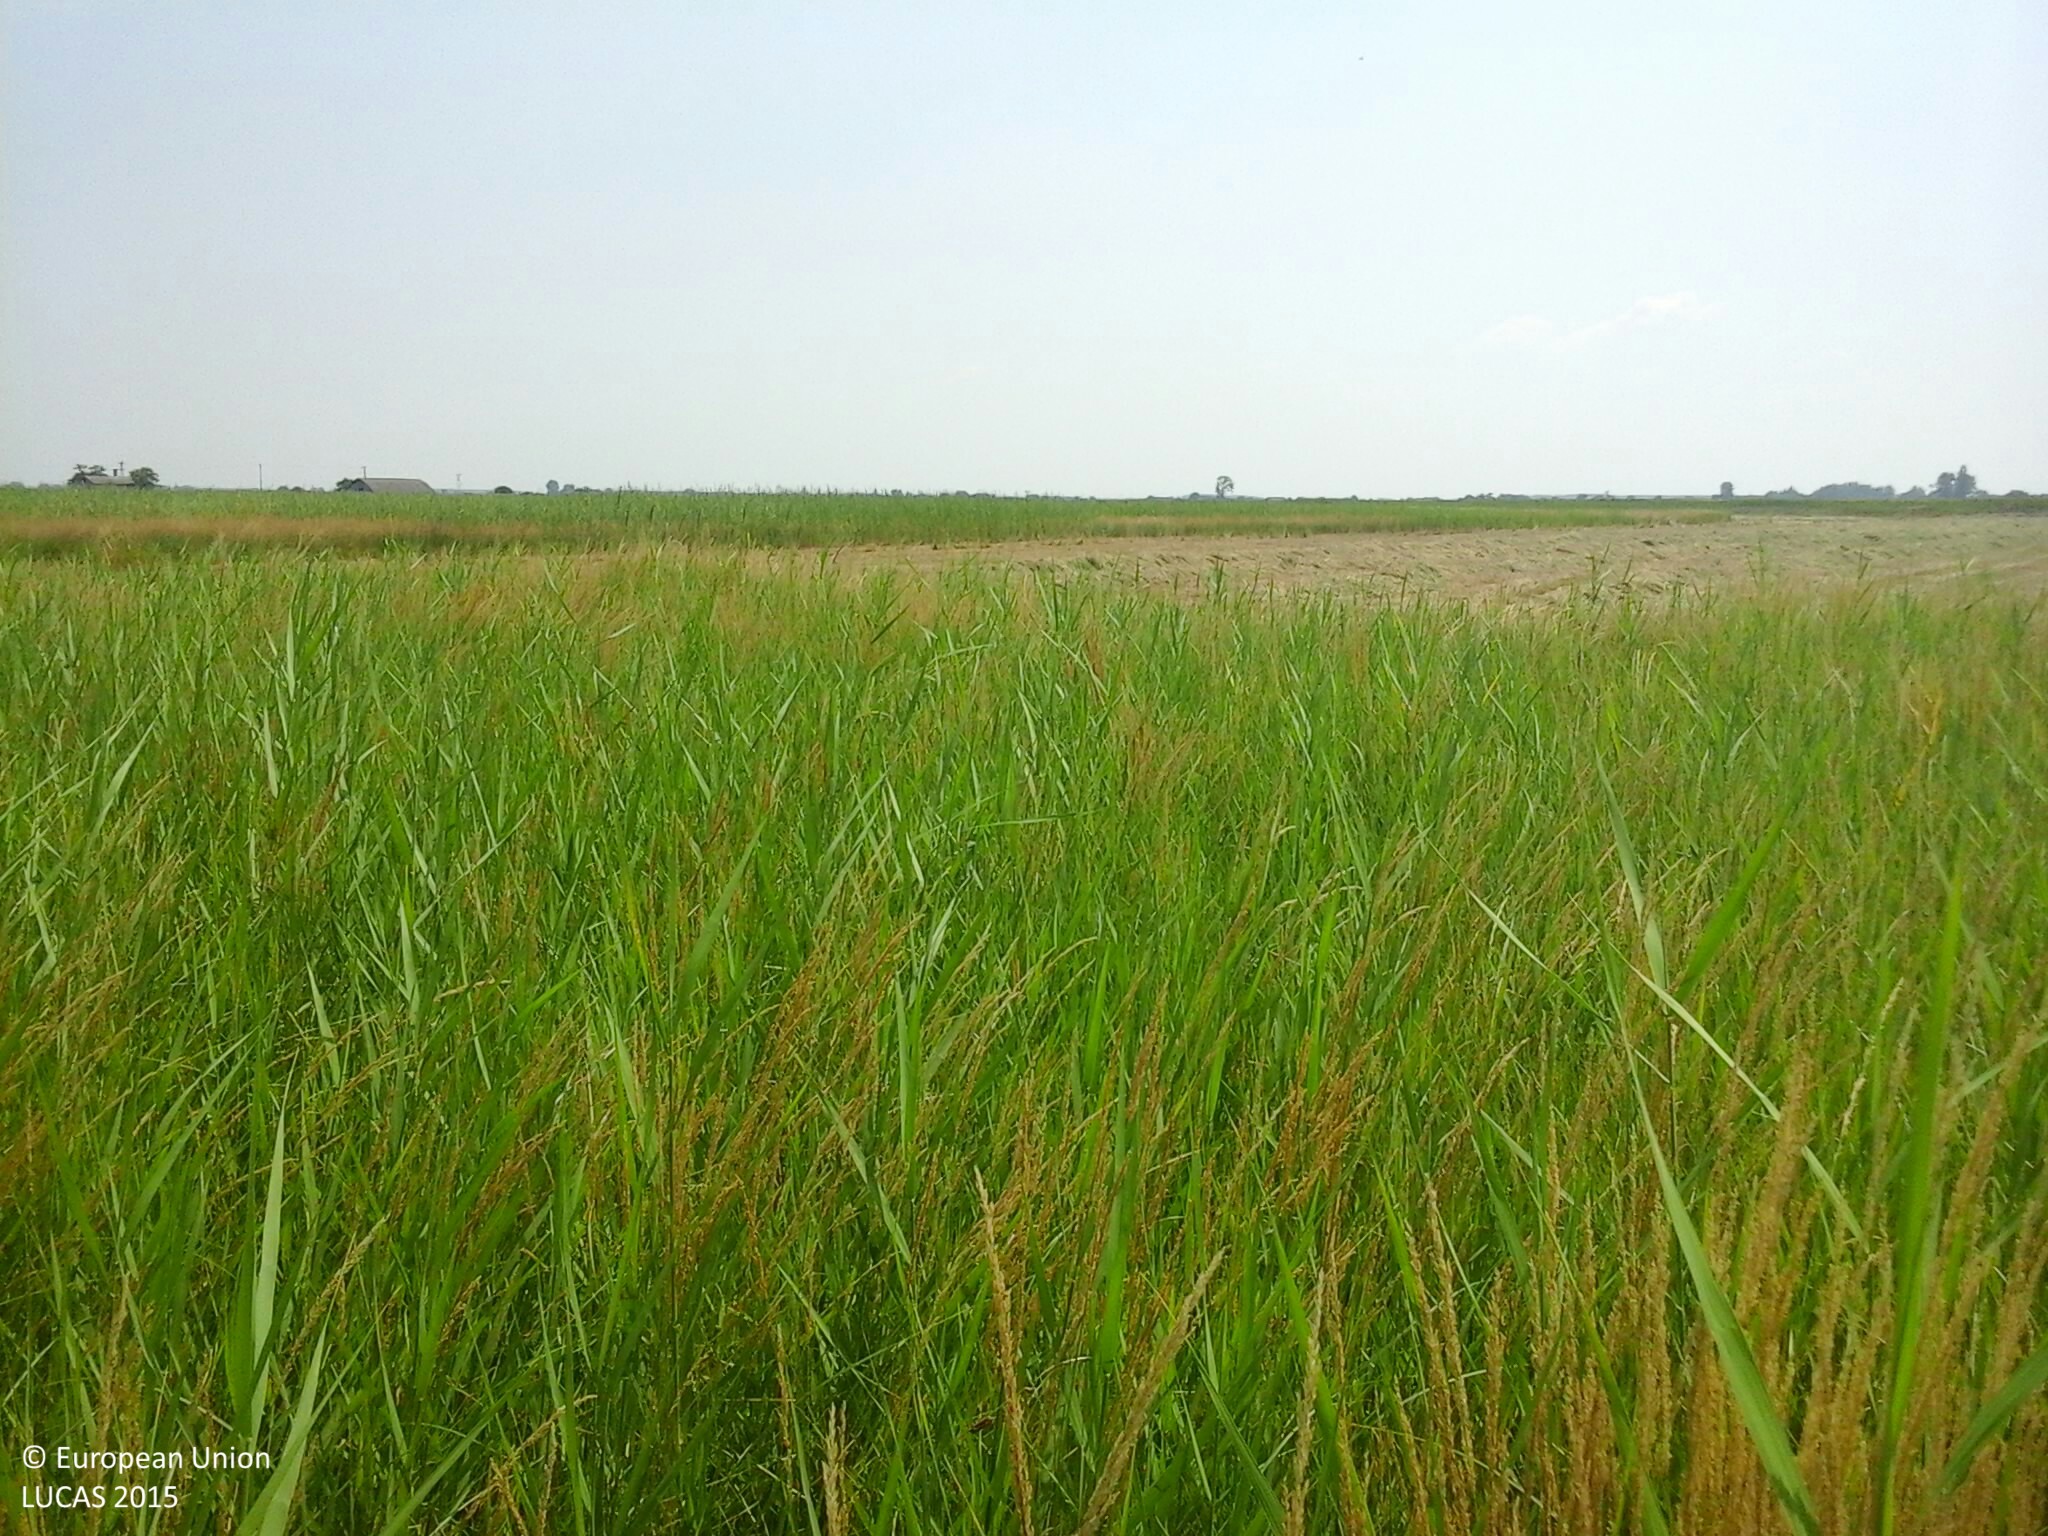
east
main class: Grassland
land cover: Grassland without tree/shrub cover
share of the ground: > 75 %
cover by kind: herbaceous plants 100 %
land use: Agriculture (excluding fallow land and kitchen gardens)
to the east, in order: Grassland without tree/shrub cover; Spontaneously vegetated surfaces; Grassland without tree/shrub cover
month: July
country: HU
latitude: 46.8434
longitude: 20.1875
